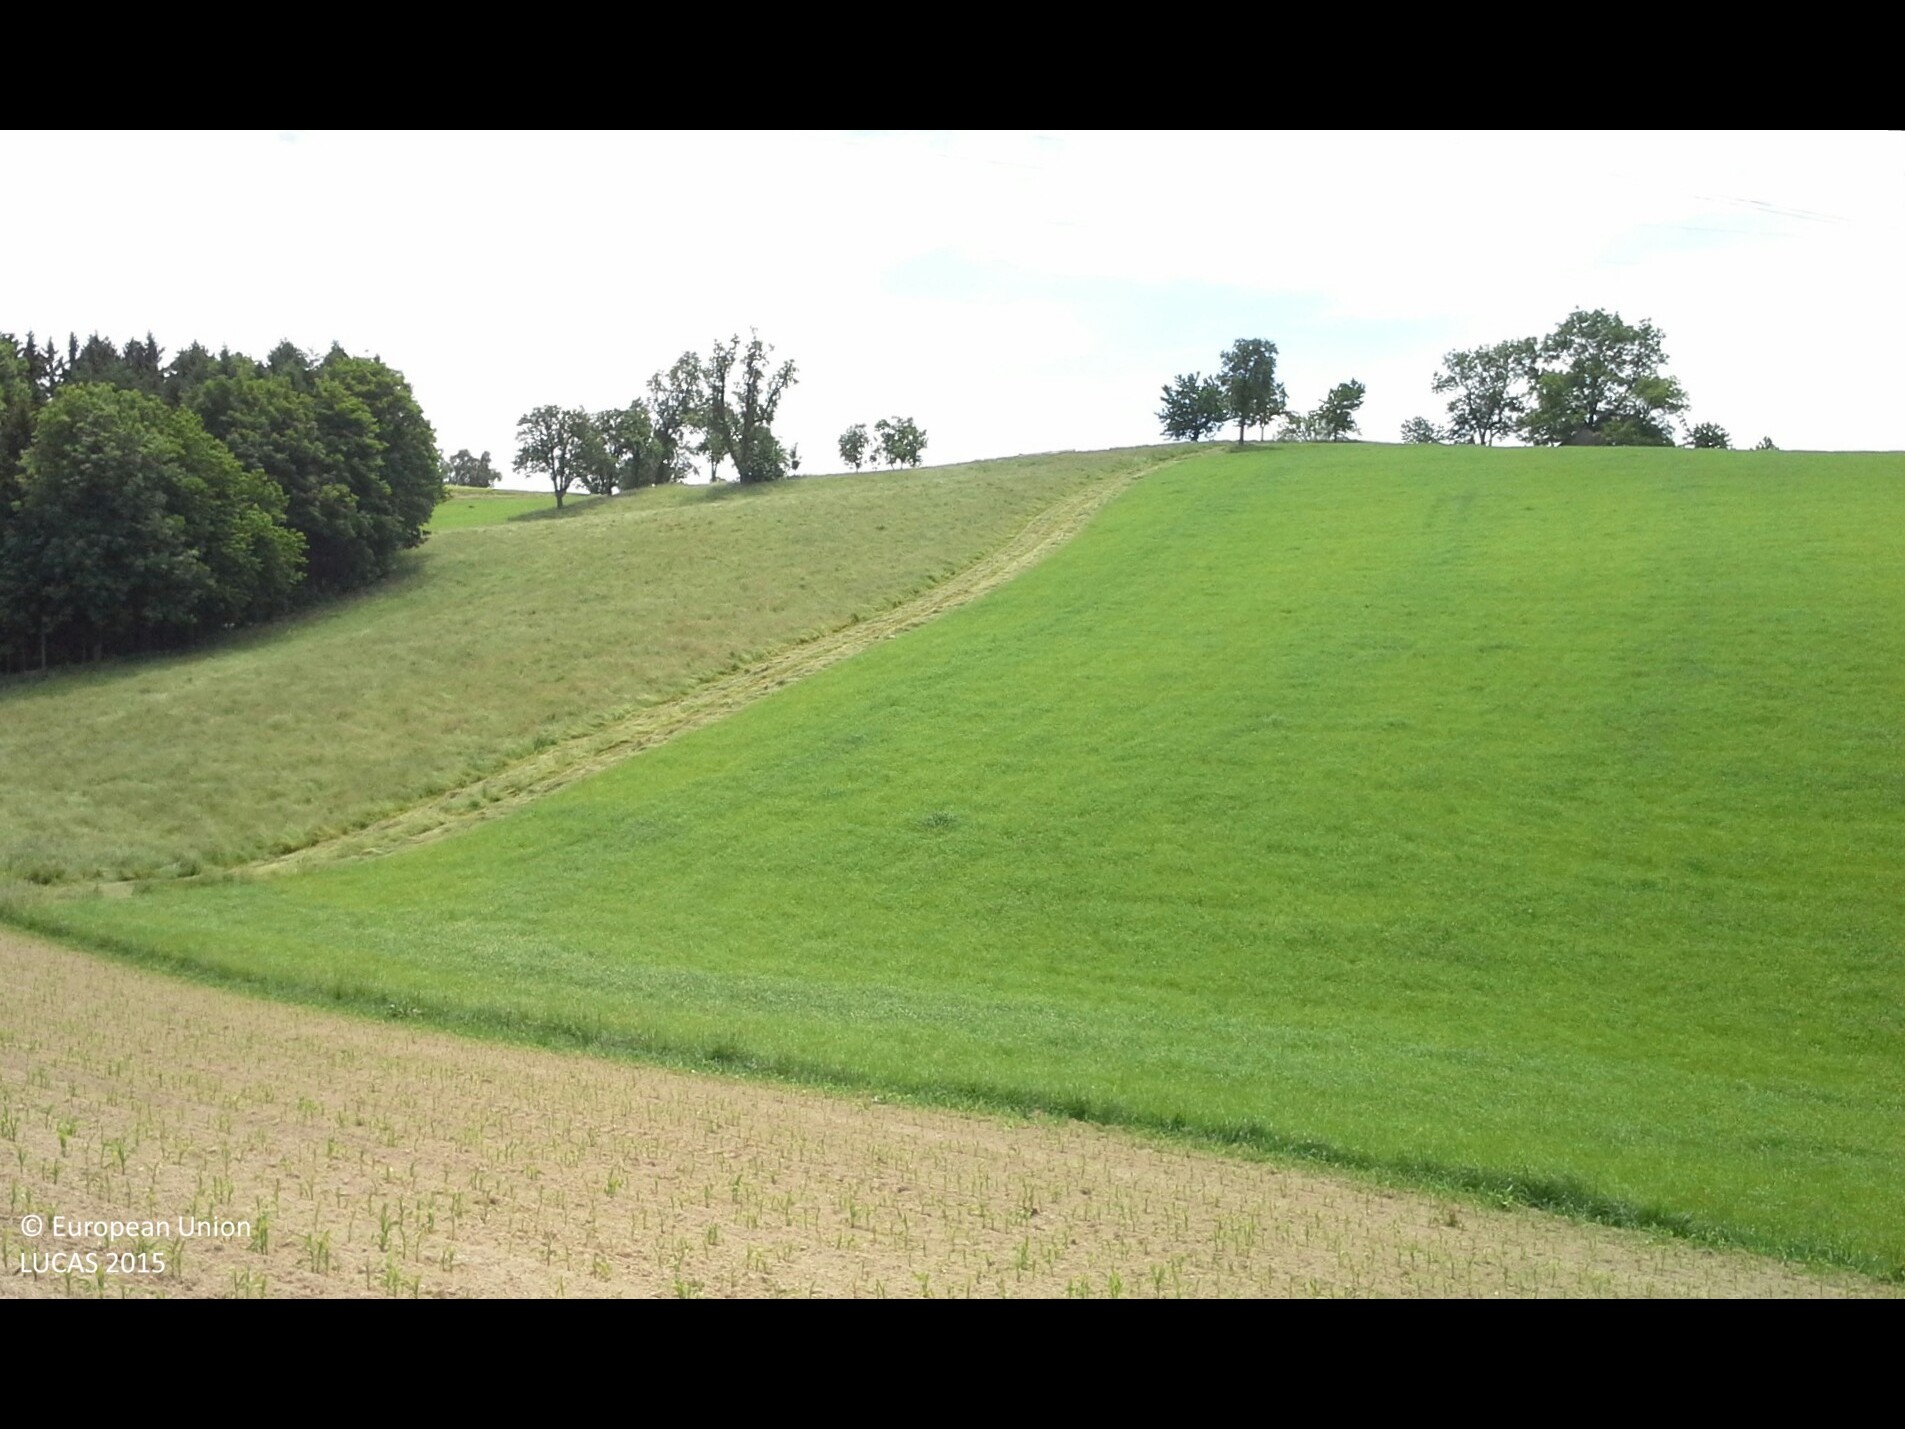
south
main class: Cropland
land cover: Maize
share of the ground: < 10 %
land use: Agriculture (excluding fallow land and kitchen gardens)
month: June
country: AT
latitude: 48.1383
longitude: 14.7713
